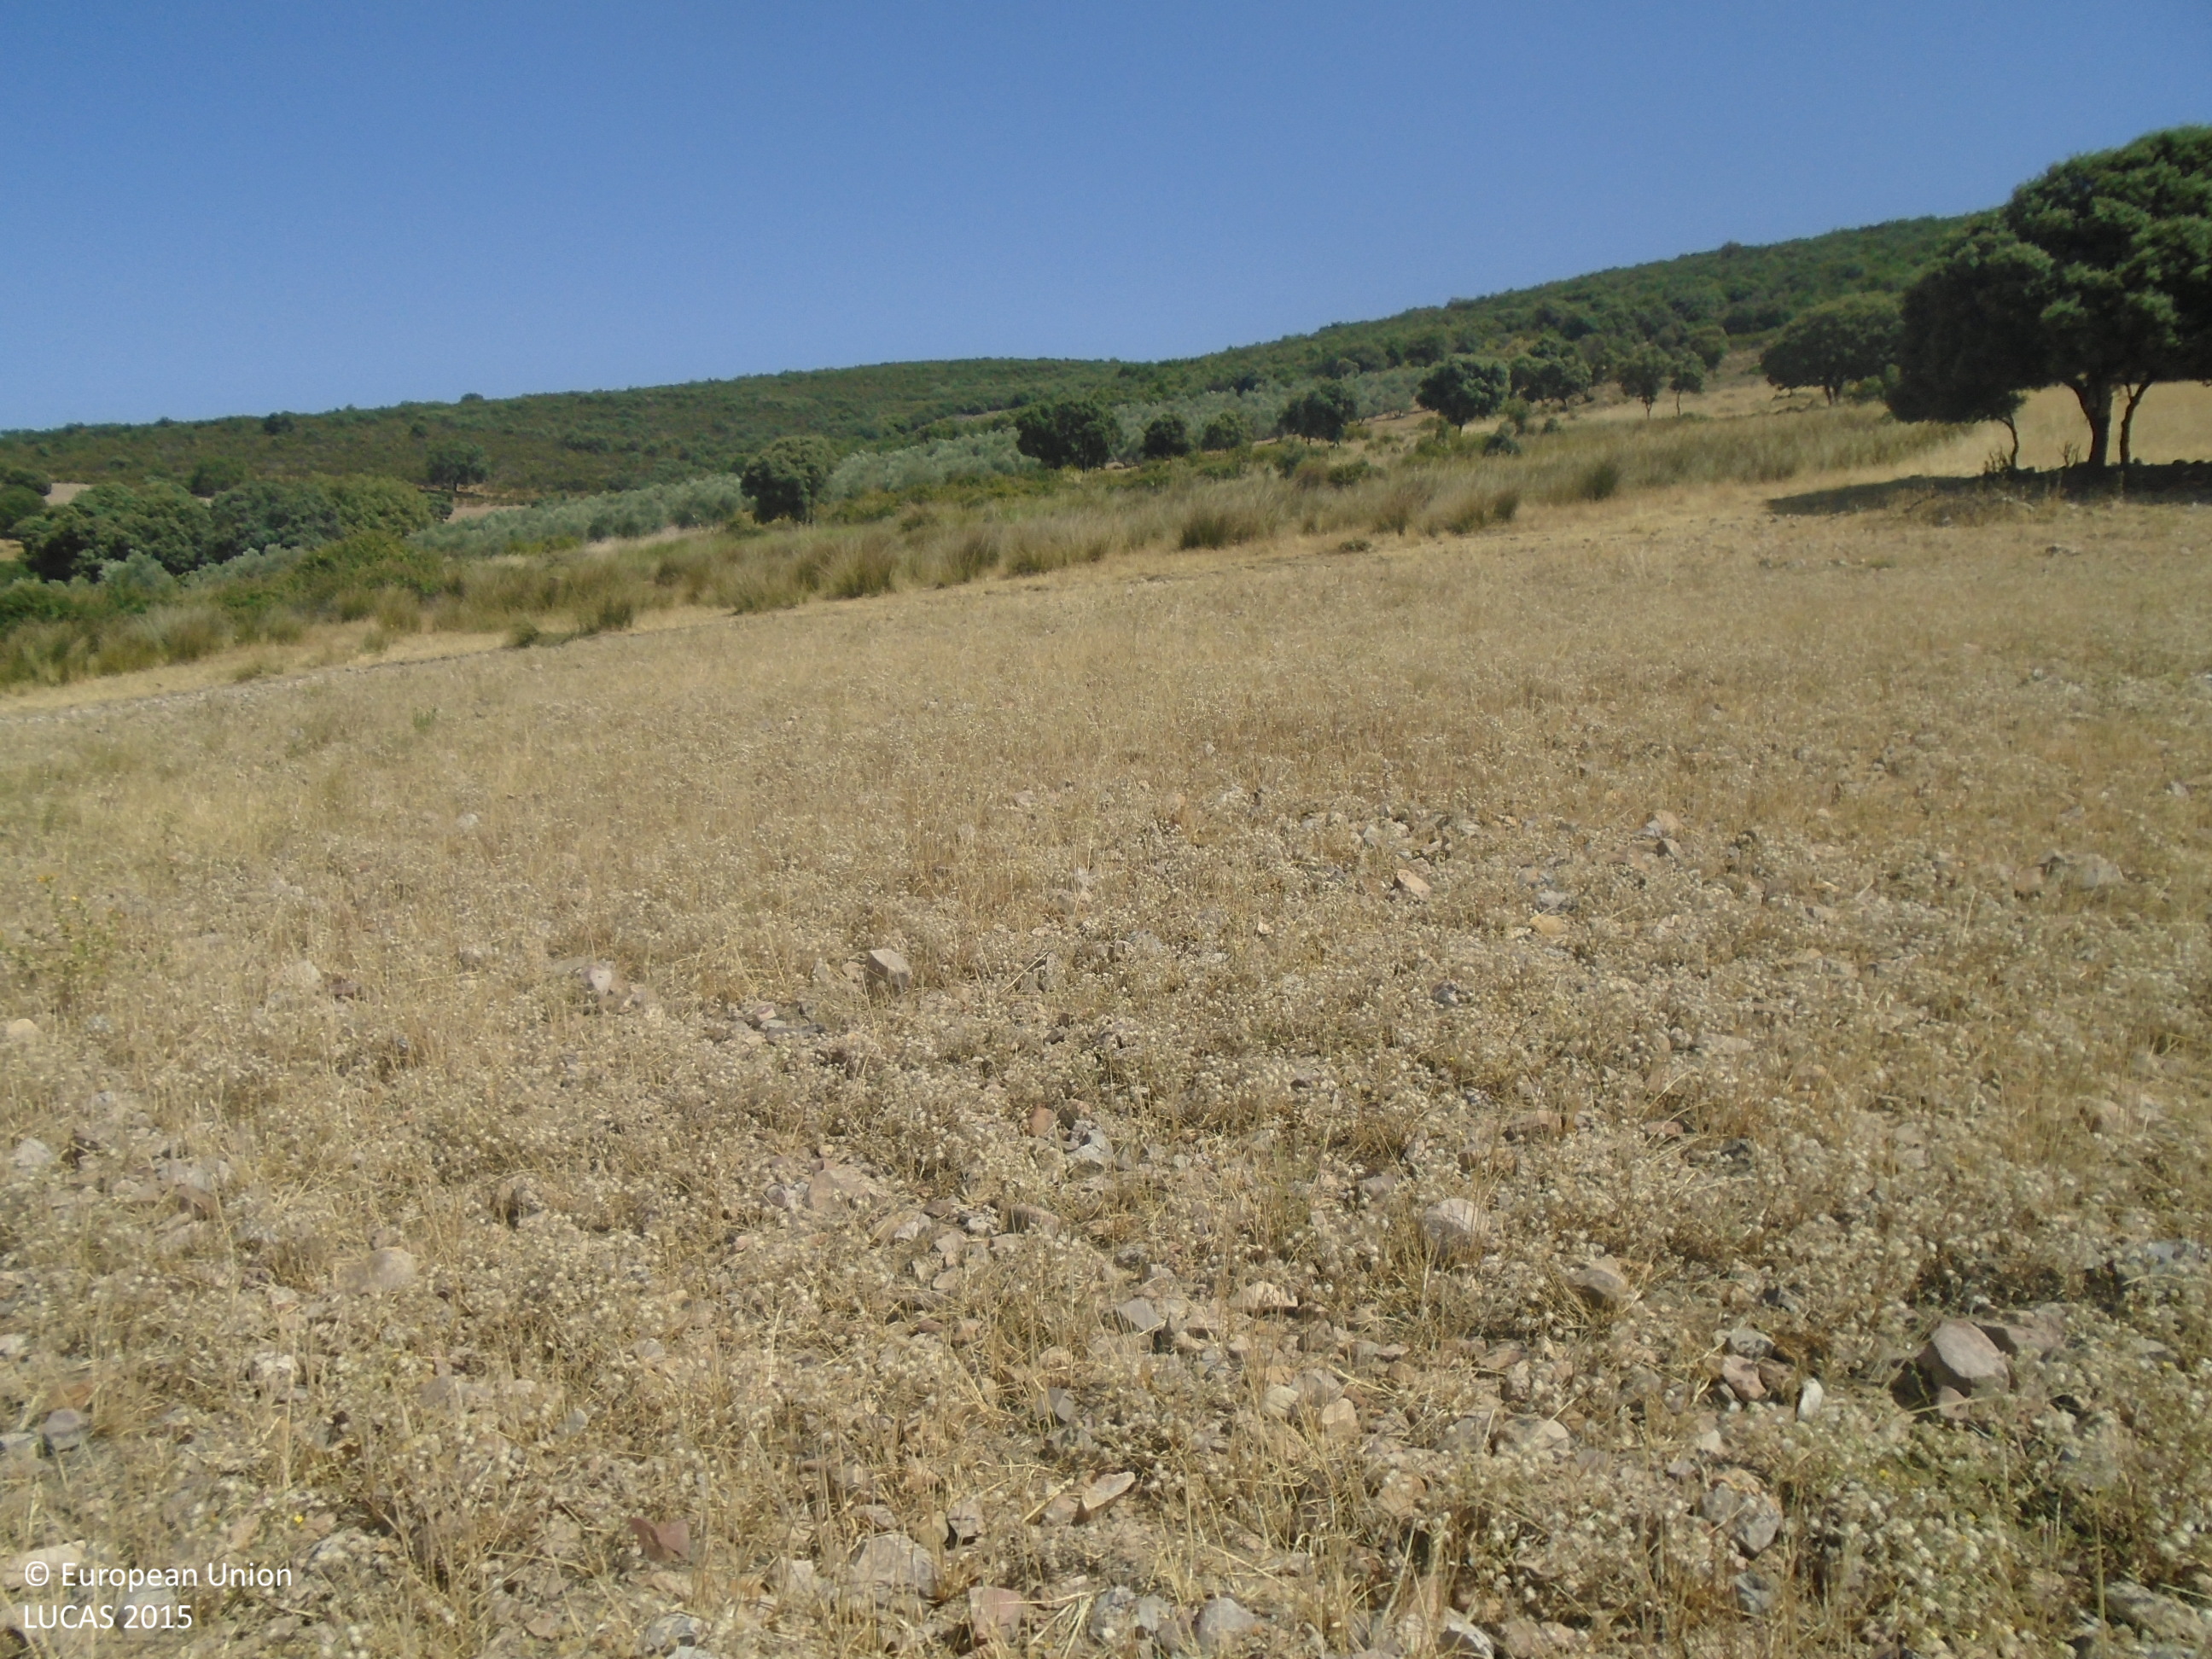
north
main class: Grassland
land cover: Spontaneously vegetated surfaces
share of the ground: > 75 %
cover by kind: herbaceous plants 80 %, consolidated bare surface 20 %
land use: Agriculture (excluding fallow land and kitchen gardens)
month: July
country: ES
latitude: 39.3383
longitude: -4.0778
